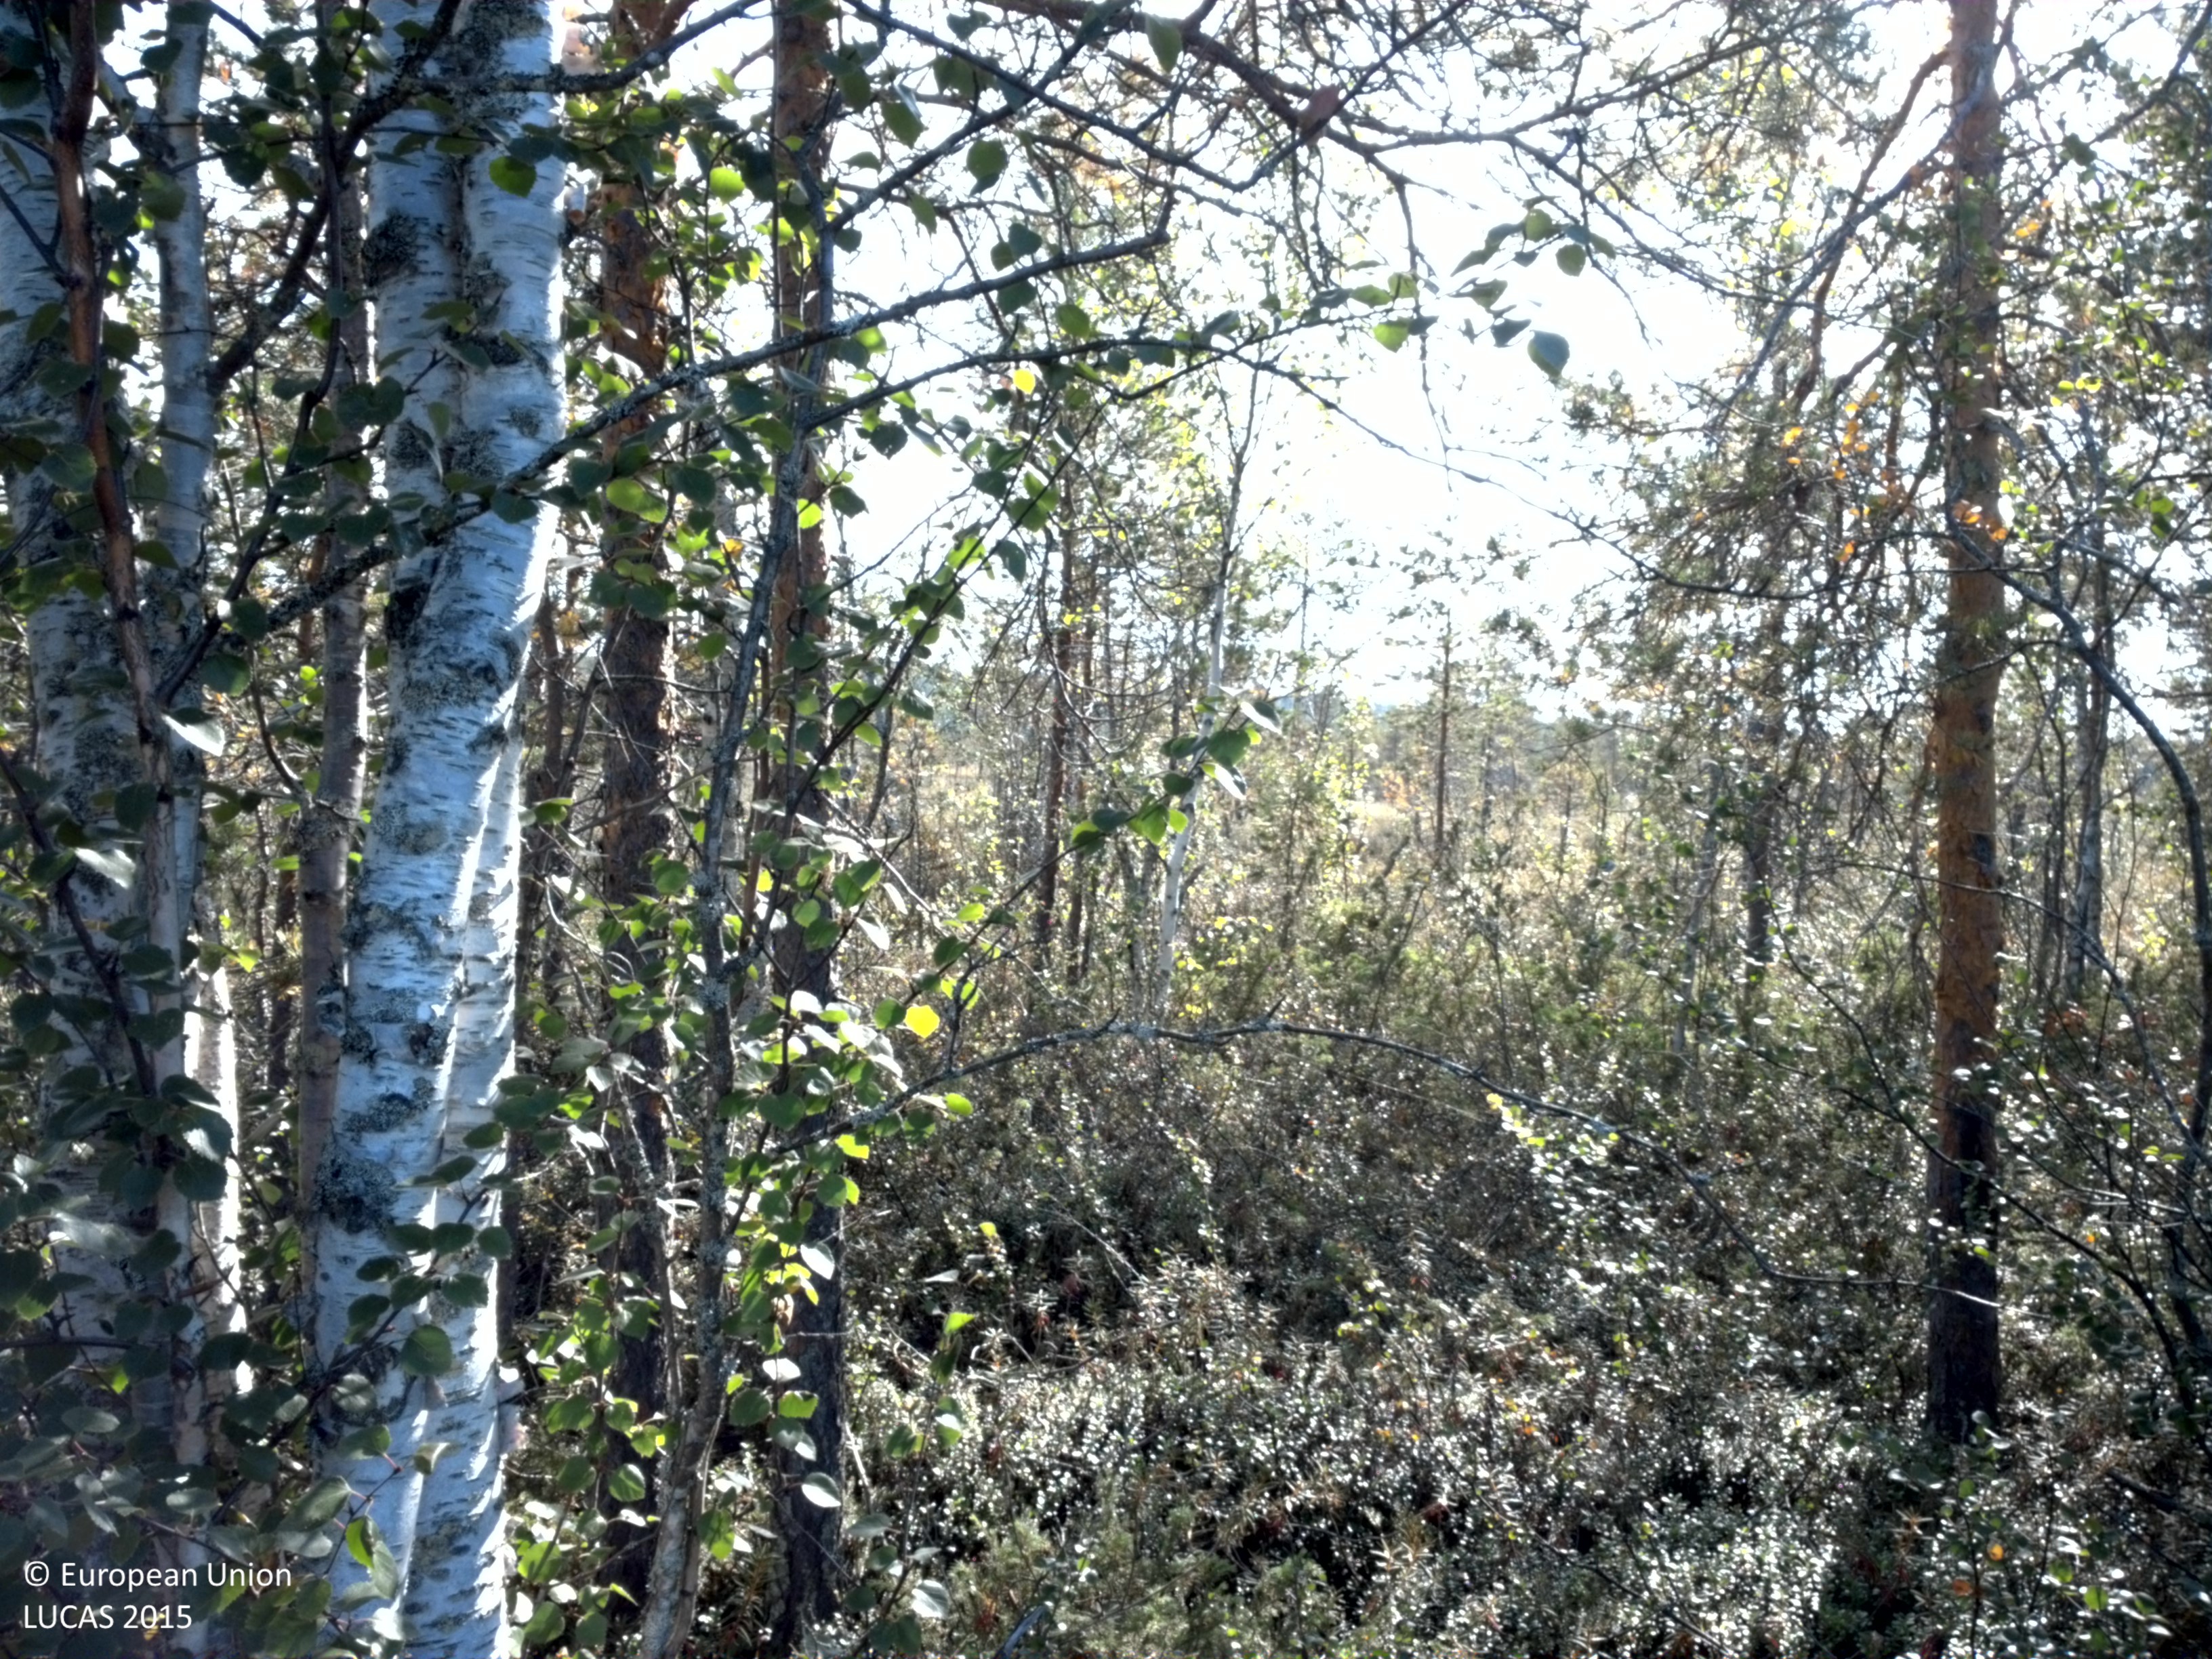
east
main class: Woodland
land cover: Pine dominated mixed woodland
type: boreal forest
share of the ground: 50 - 75 %
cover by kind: coniferous forest trees 45 %, shrubs 35 %, broadleaved forest trees 15 %, lichens and mosses 5 %
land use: Semi-natural and natural areas not in use
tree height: > 5 m
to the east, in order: Pine dominated mixed woodland; Pine dominated coniferous woodland; Peatbogs; Pine dominated coniferous woodland
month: August
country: SE
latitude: 64.6124
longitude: 18.7269
